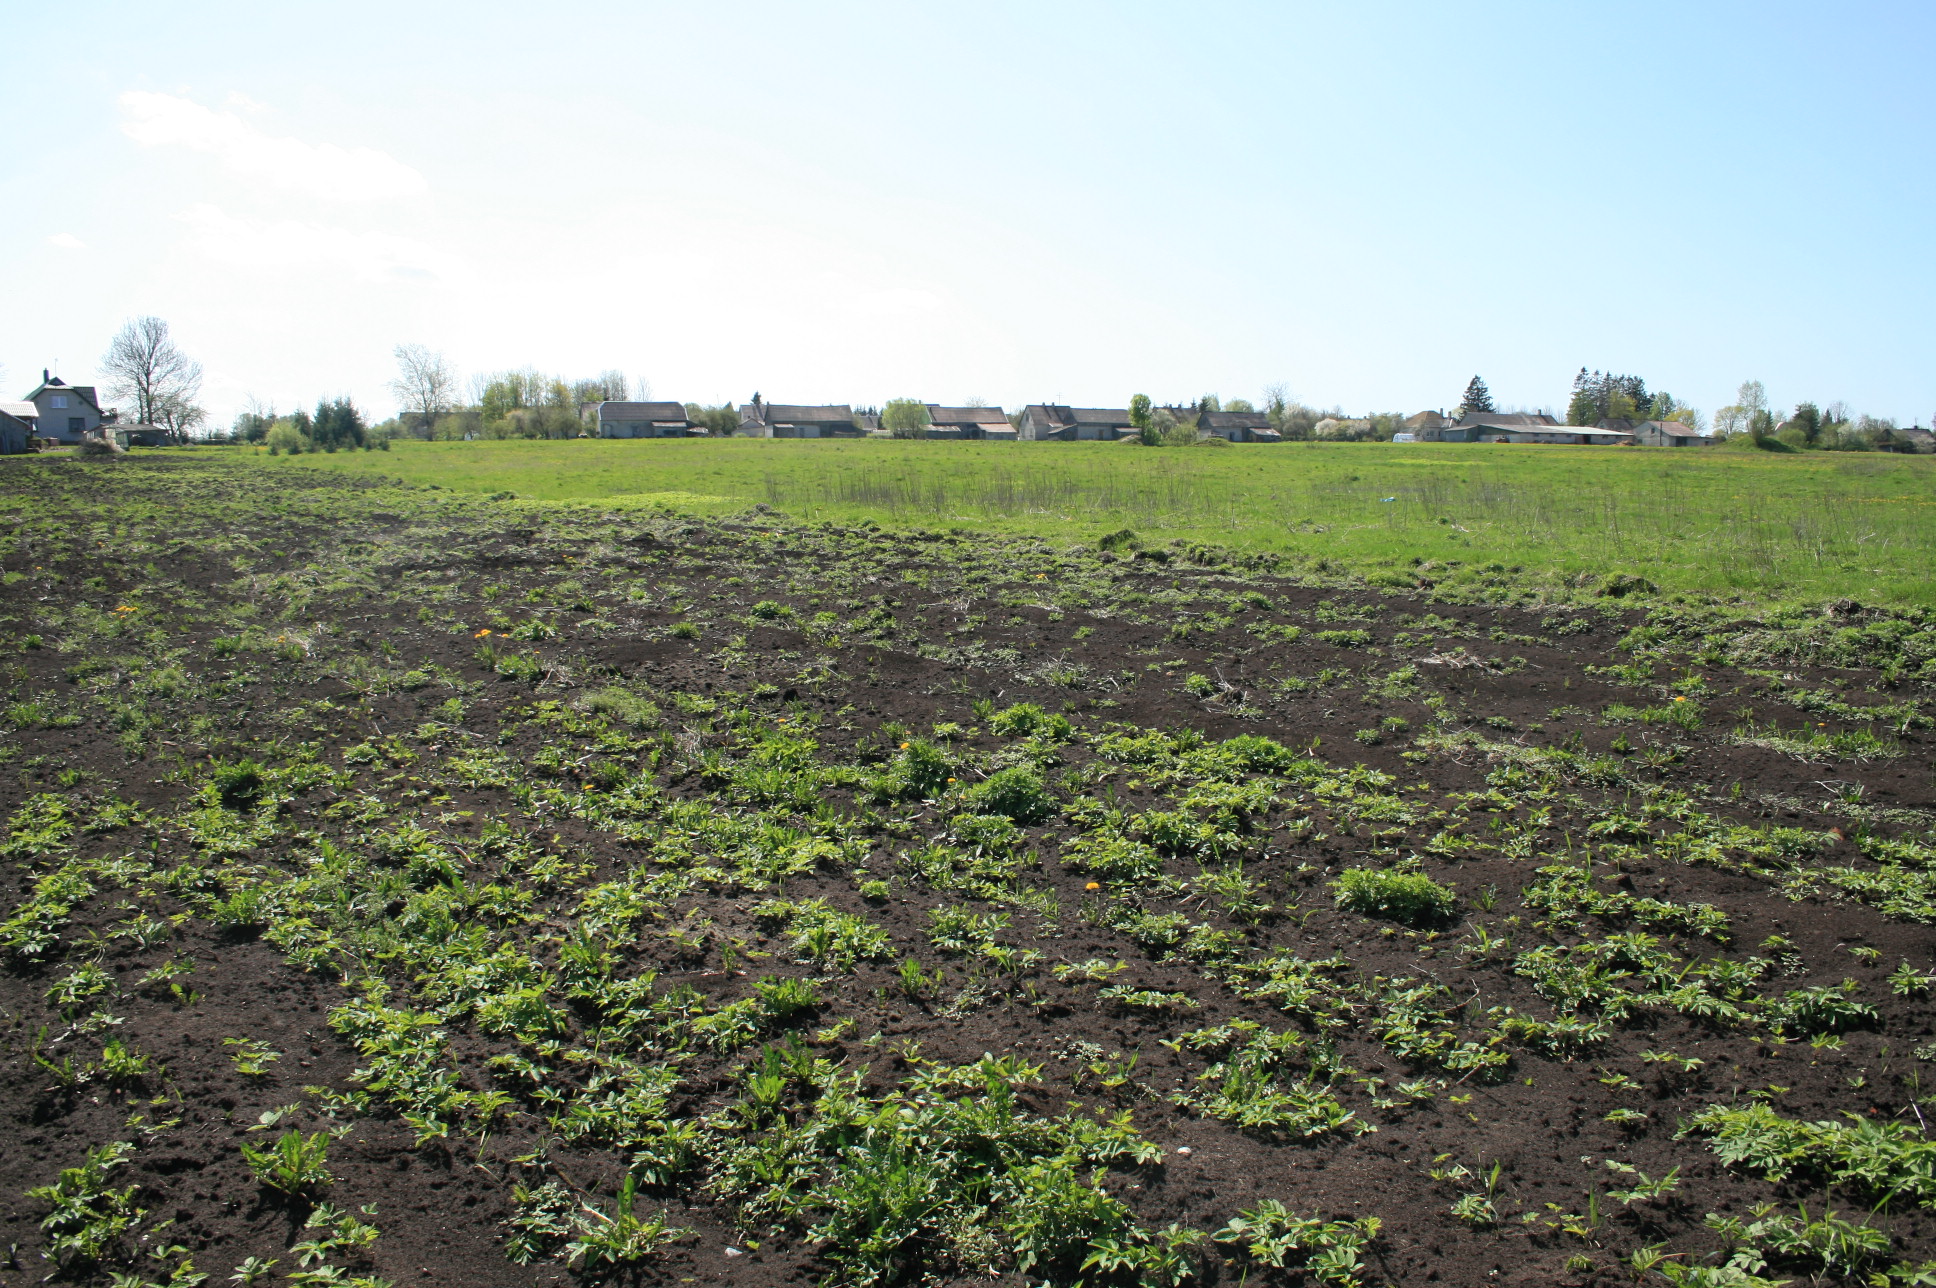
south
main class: Grassland
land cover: Spontaneously vegetated surfaces
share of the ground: 50 - 75 %
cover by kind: herbaceous plants 65 %, unconsolidated bare surface 35 %
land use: Fallow land
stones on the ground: < 10 %
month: May
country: LT
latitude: 56.2992
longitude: 21.5660
